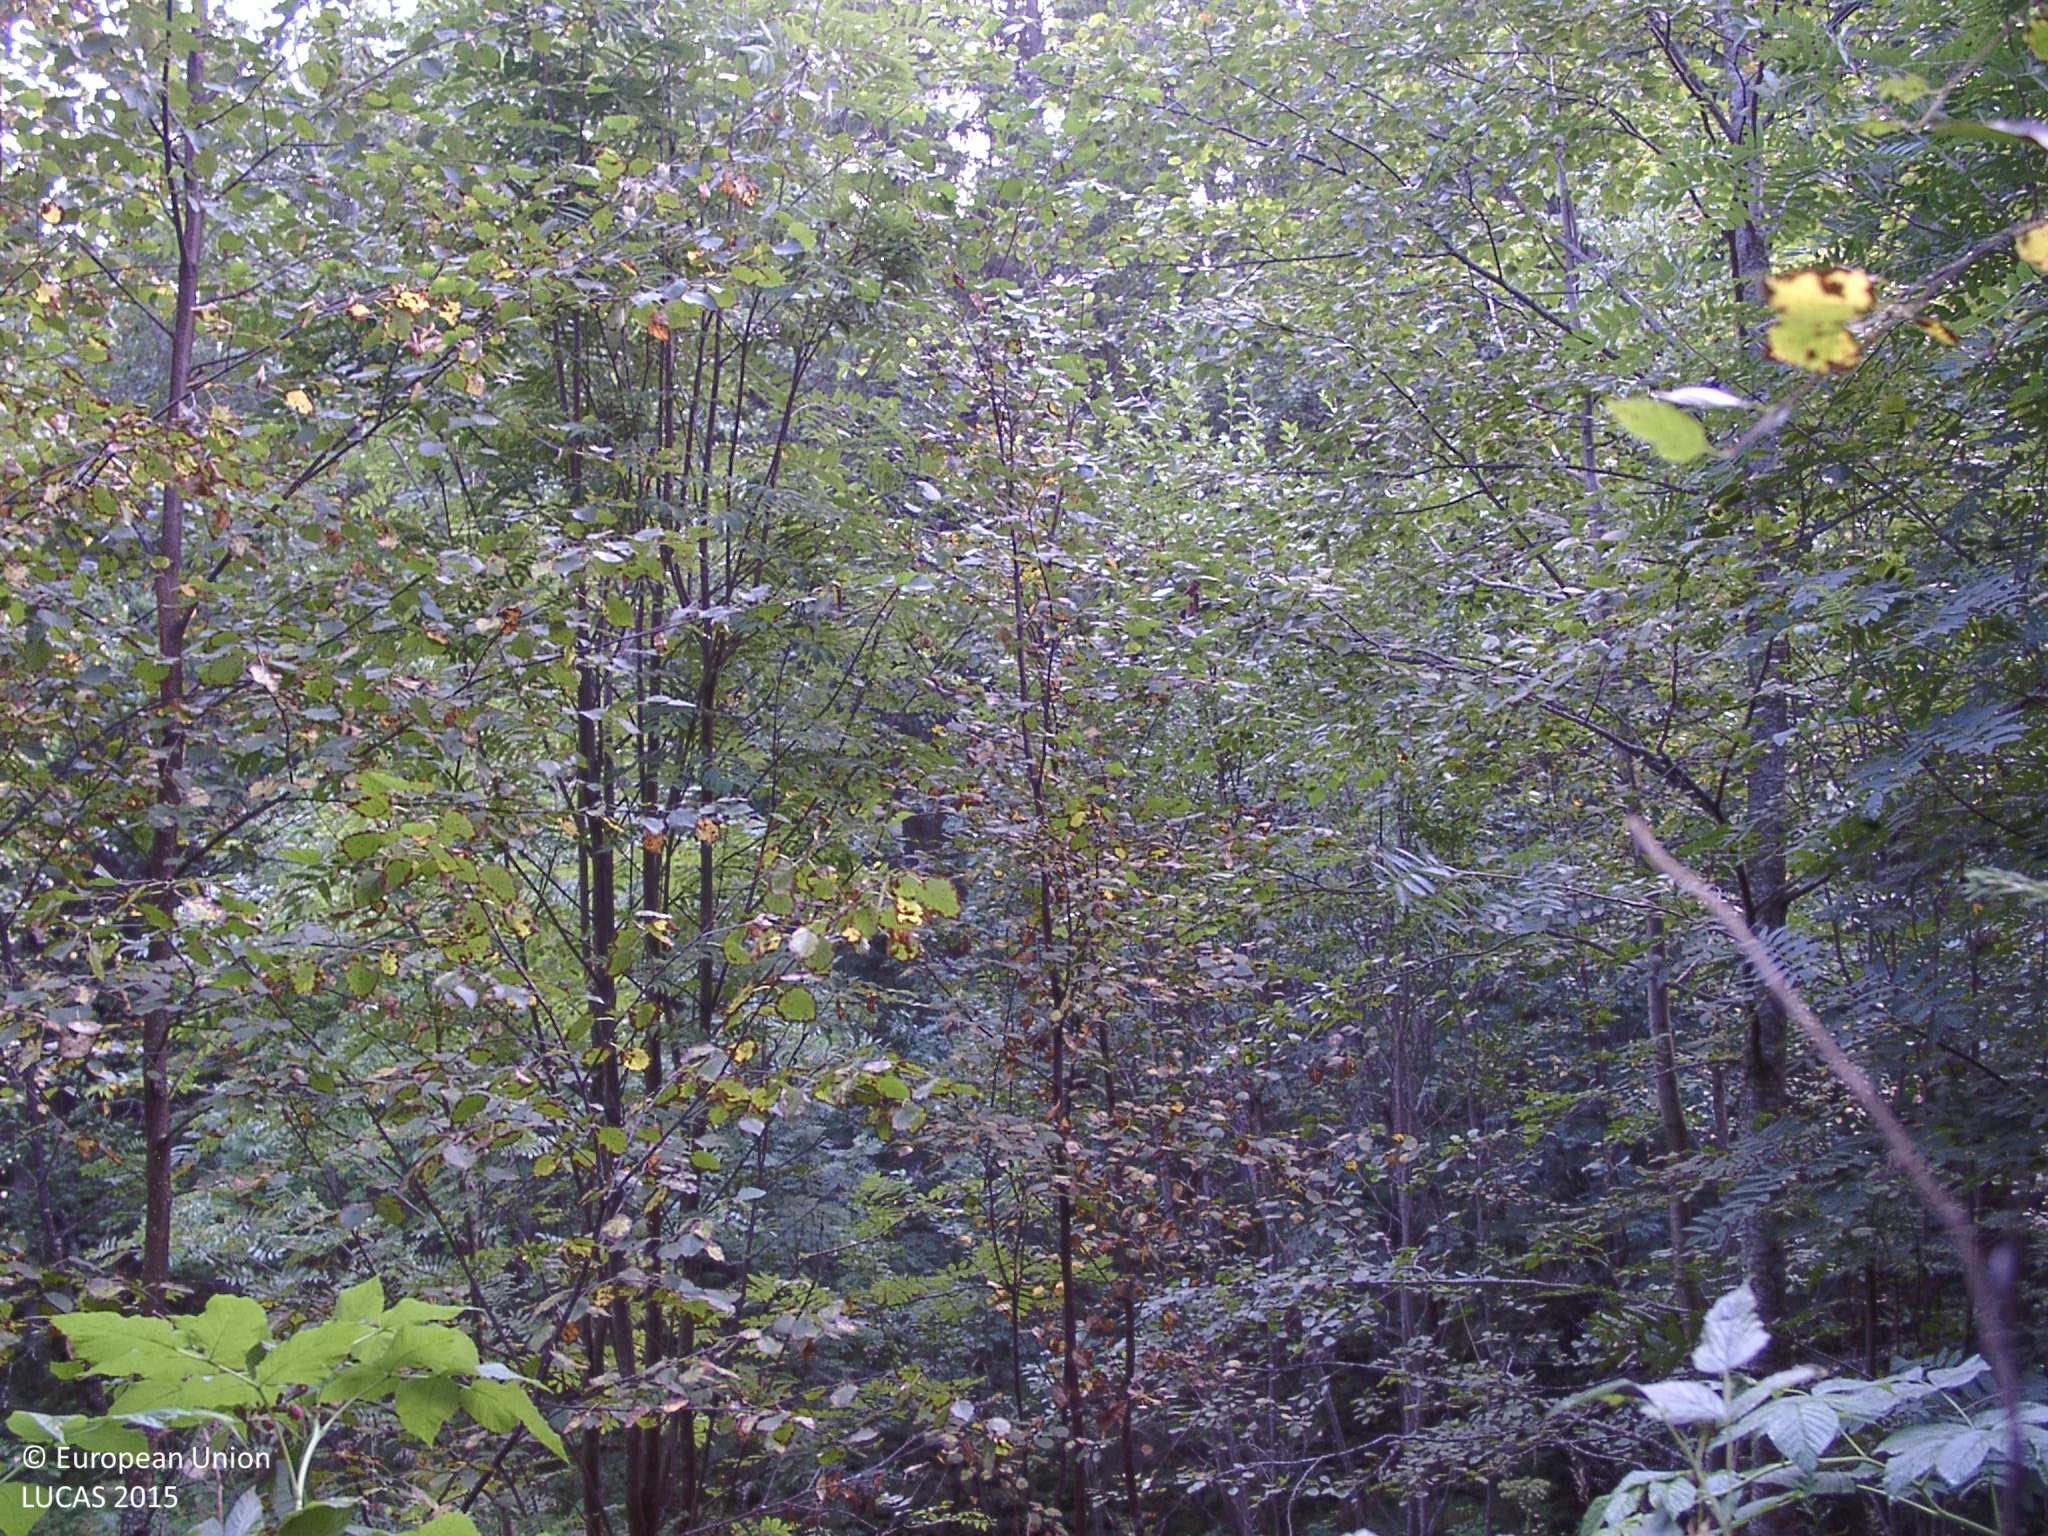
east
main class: Woodland
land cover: Broadleaved woodland
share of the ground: 50 - 75 %
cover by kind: broadleaved forest trees 55 %, herbaceous plants 20 %, shrubs 15 %, coniferous forest trees 10 %
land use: Forestry
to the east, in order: Broadleaved woodland; Ditches and canals; Spruce dominated mixed woodland; Shruby margins; Spruce dominated coniferous woodland; Spruce dominated mixed woodland; Grass margins; Spruce dominated mixed woodland; Grassland with sparse tree/shrub cover; Spruce dominated mixed woodland; Grass margins
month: August
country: FI
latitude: 61.8057
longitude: 25.1171
